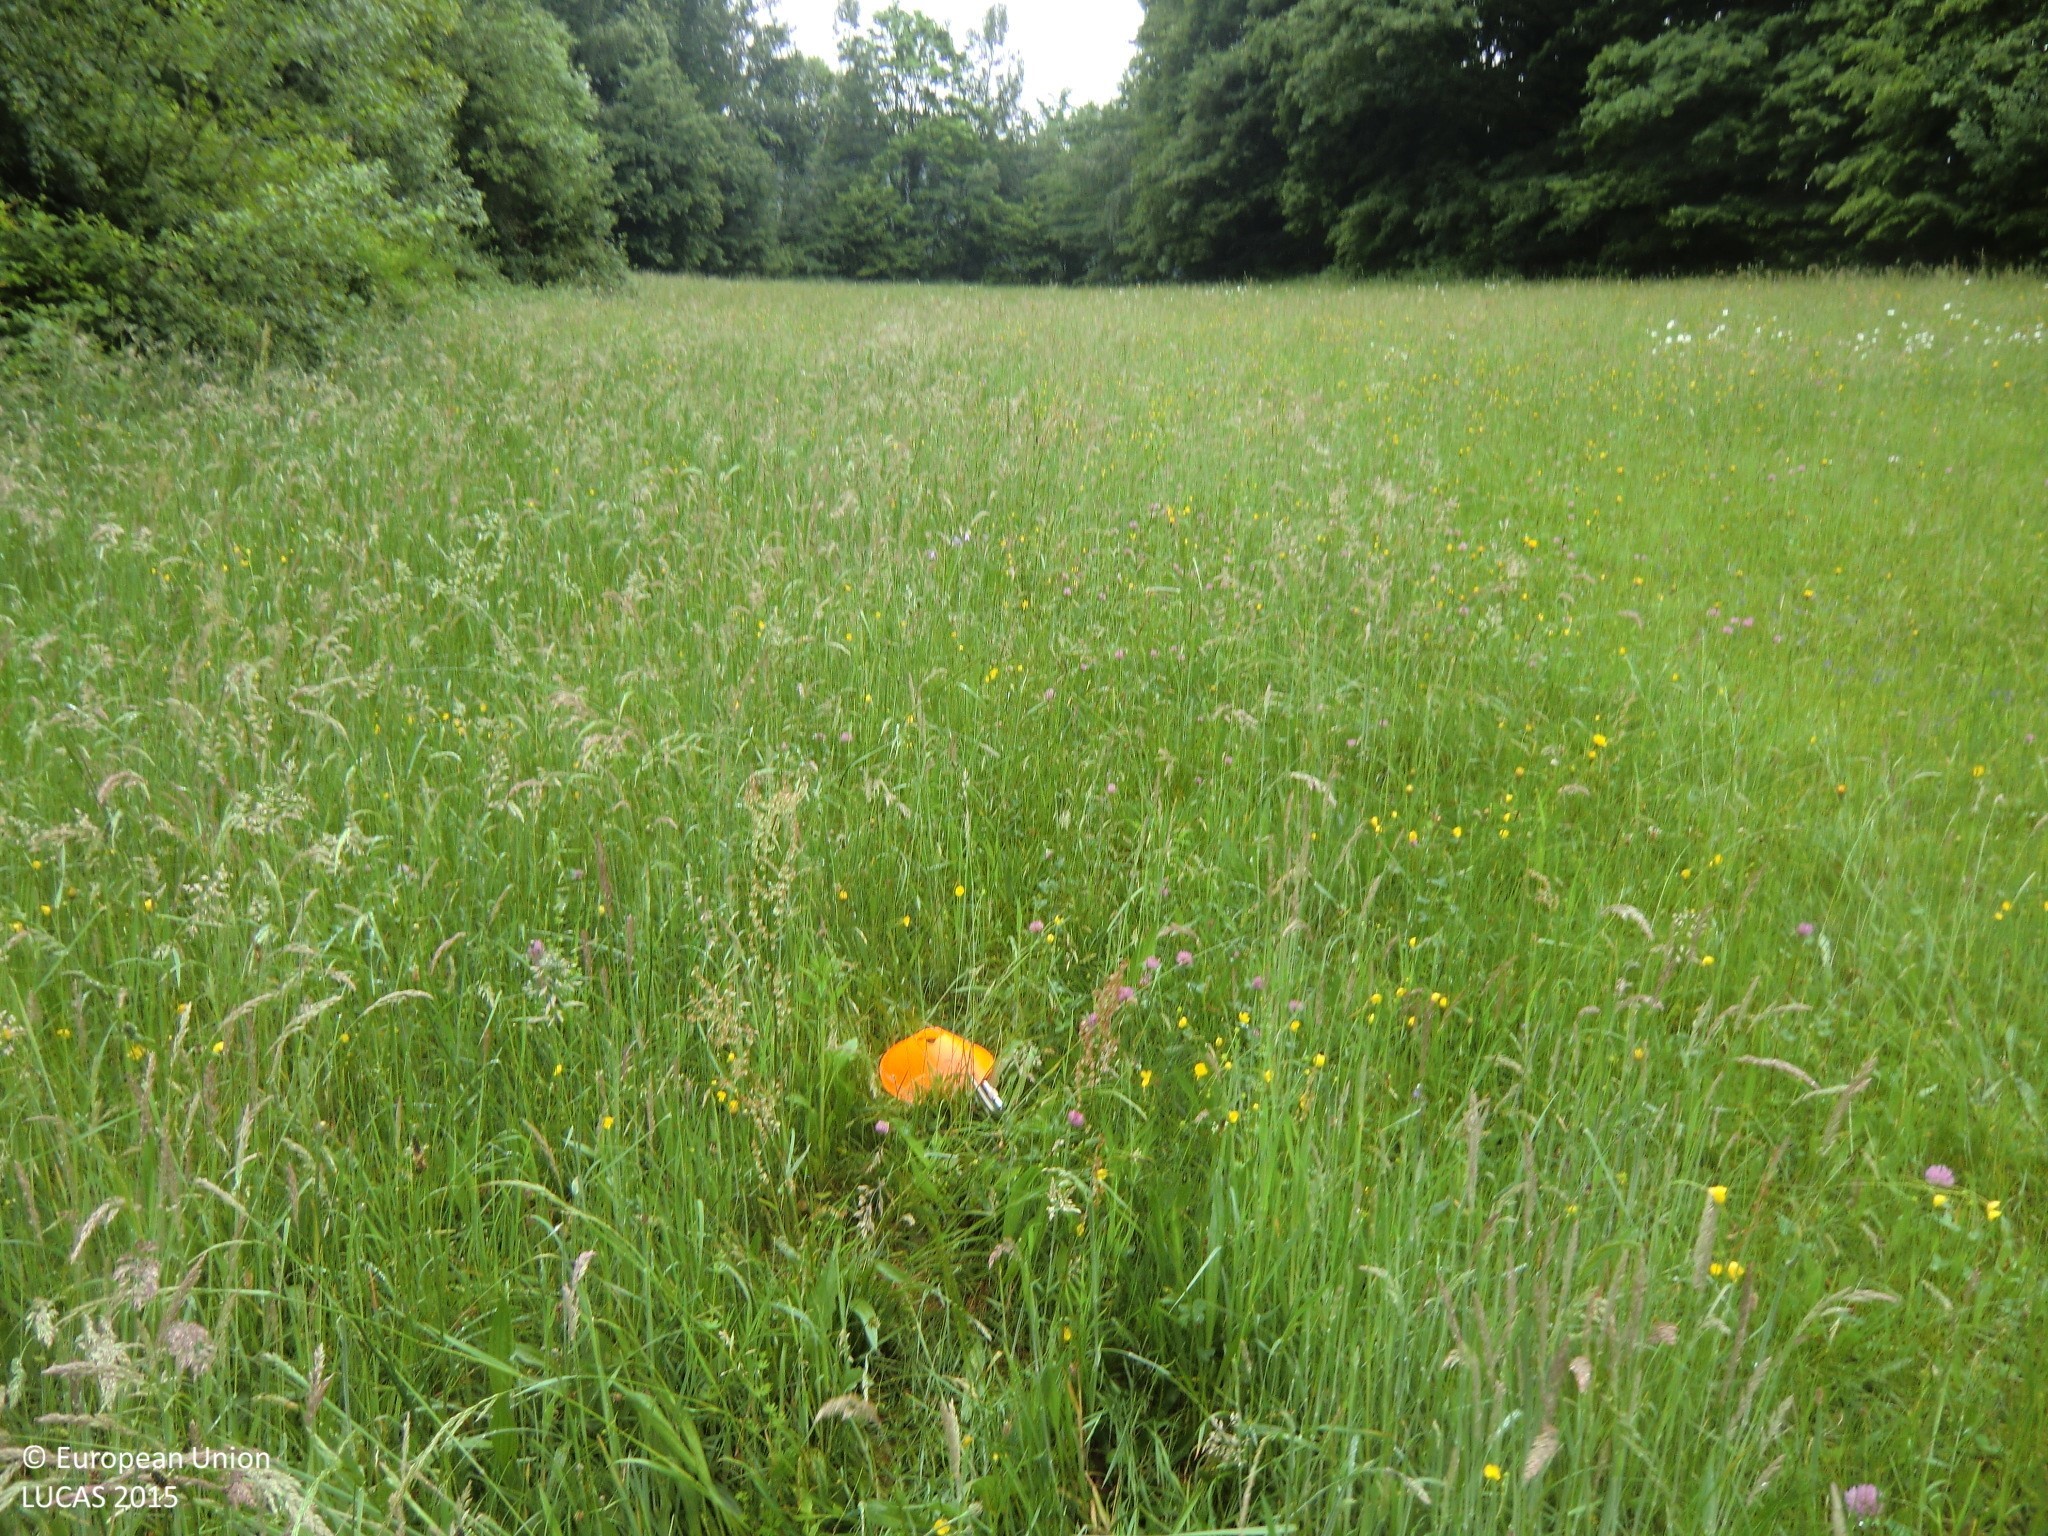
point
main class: Grassland
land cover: Grassland without tree/shrub cover
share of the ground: > 75 %
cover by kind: herbaceous plants 100 %
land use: Agriculture (excluding fallow land and kitchen gardens)
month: May
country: AT
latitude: 47.2875
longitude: 15.9383
